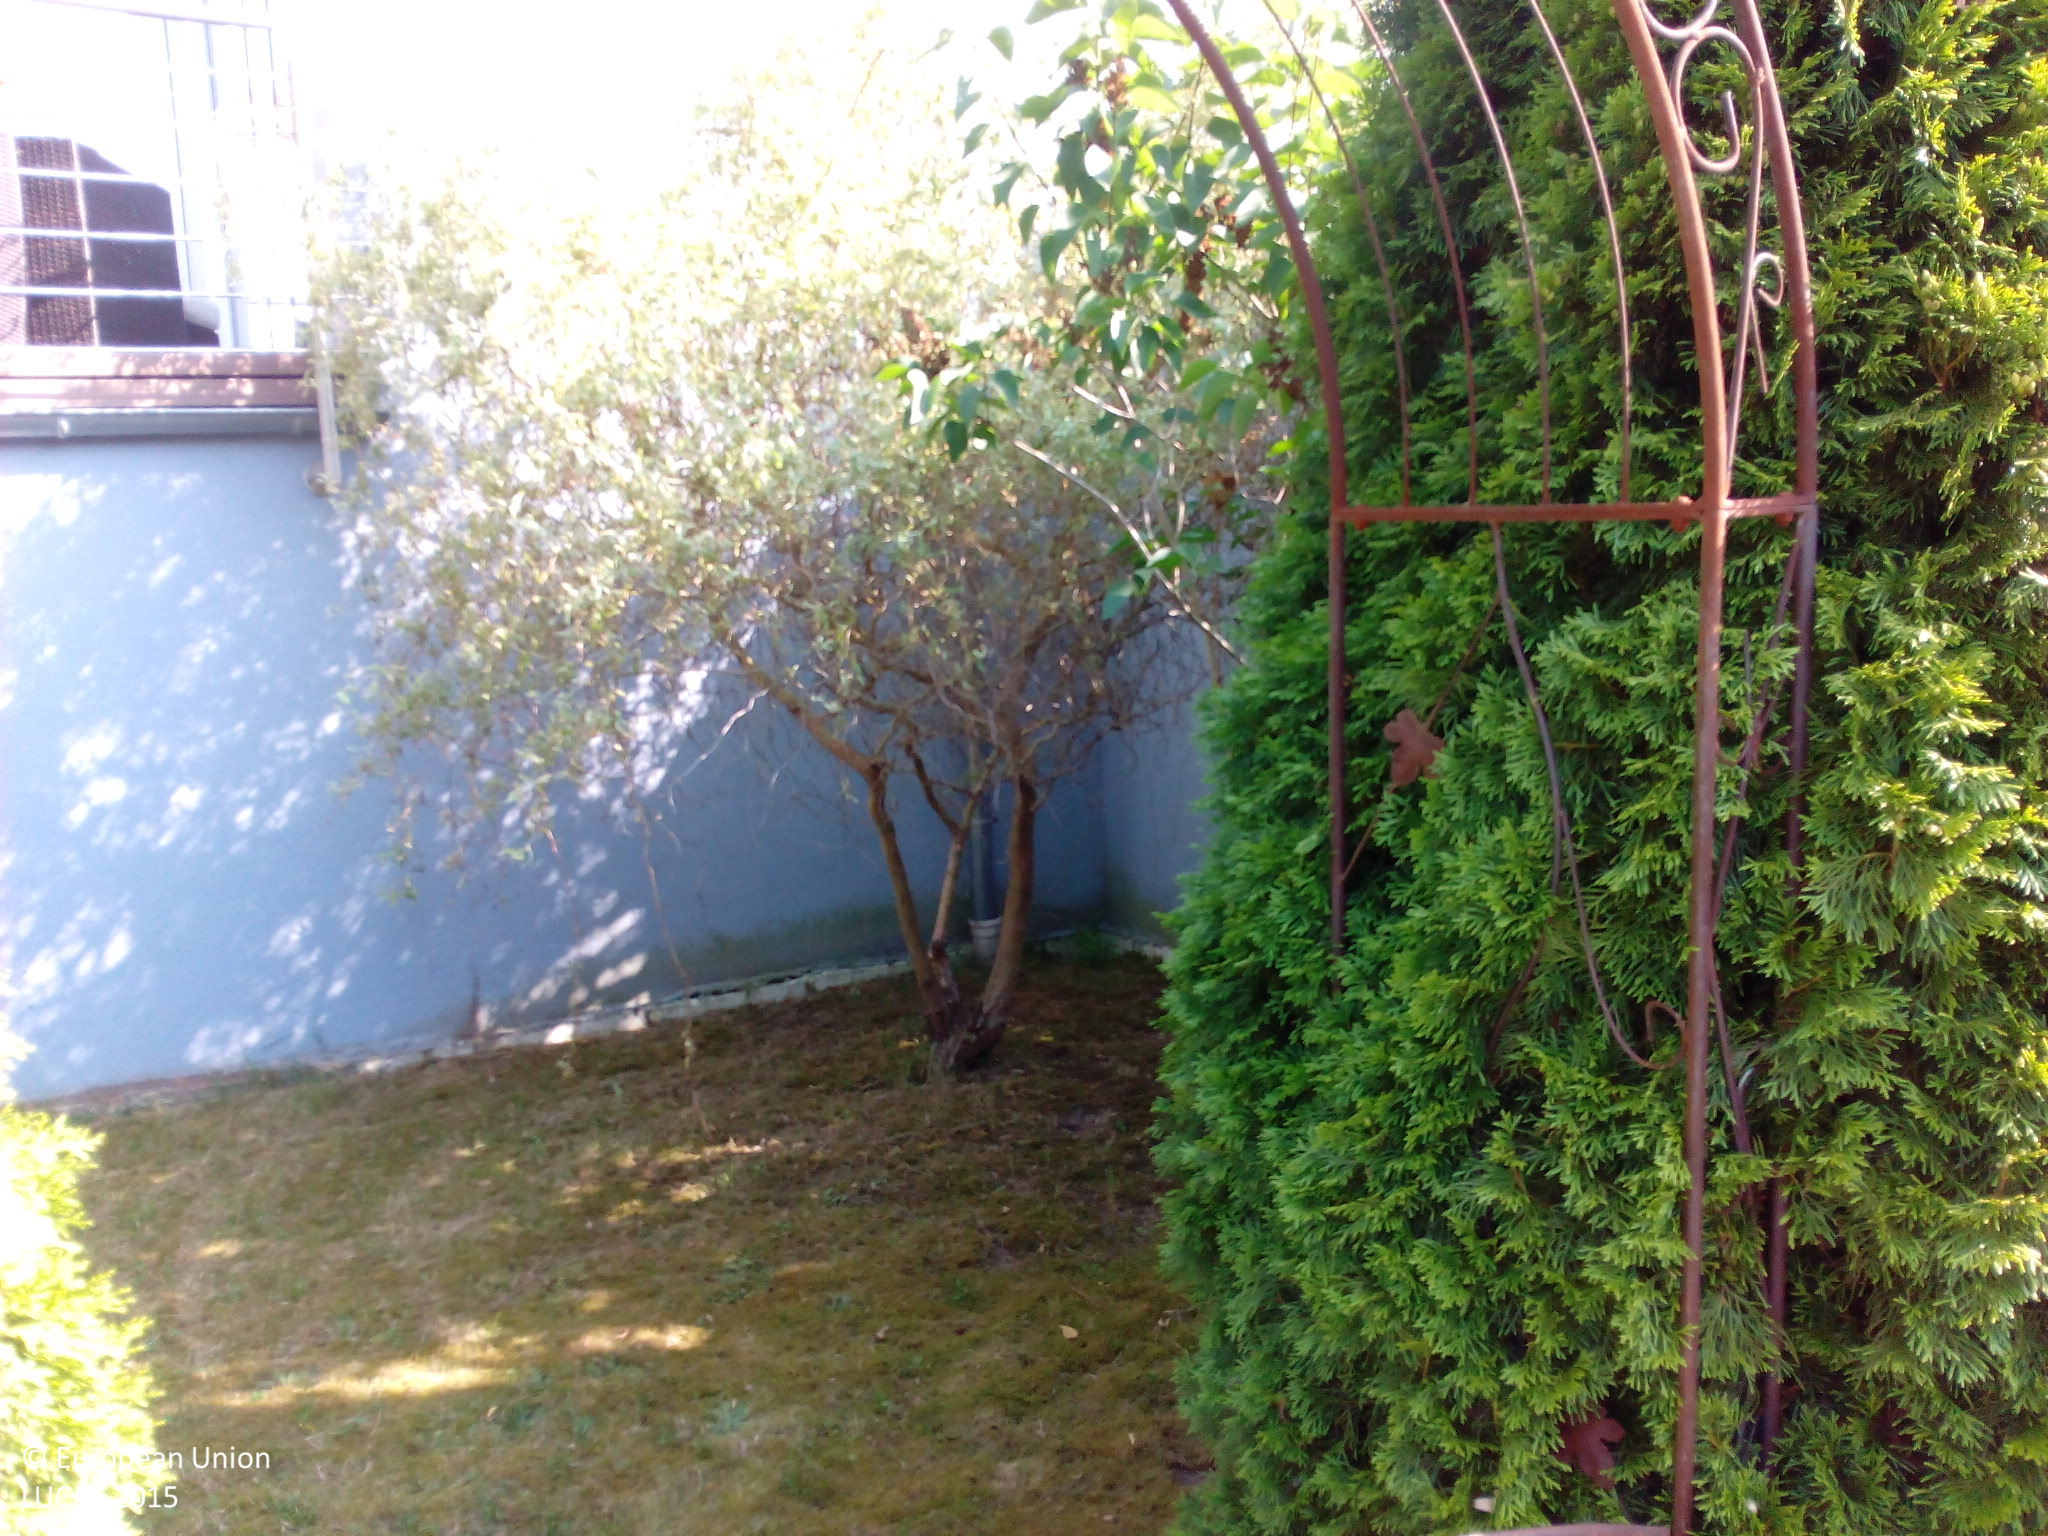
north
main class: Cropland
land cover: Cherry fruit
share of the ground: 25 - 50 %
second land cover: Grassland without tree/shrub cover
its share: > 75 %
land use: Kitchen garden
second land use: Residential
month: July
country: DE
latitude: 49.2850
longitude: 7.1546
